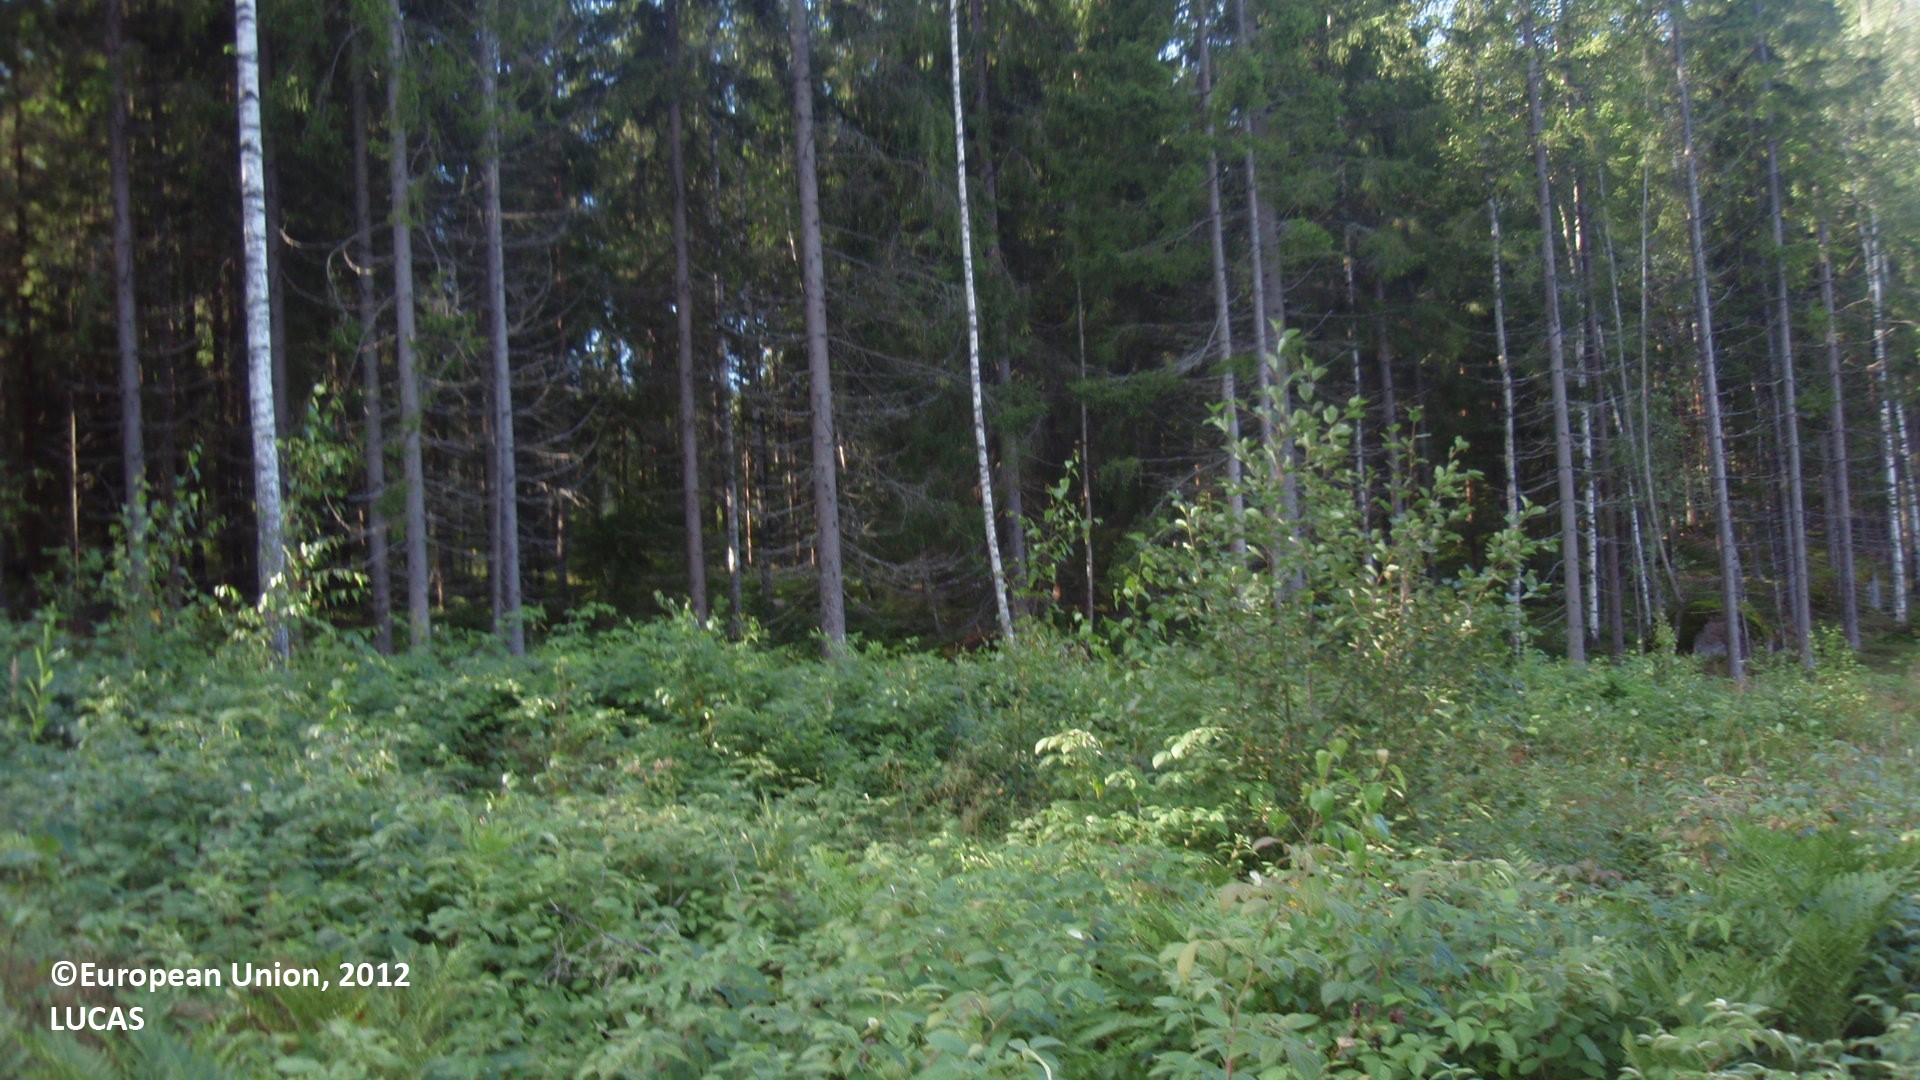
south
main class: Shrubland
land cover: Shrubland with sparse tree cover
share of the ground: > 75 %
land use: Forestry
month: August
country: FI
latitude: 60.6509
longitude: 27.1666
